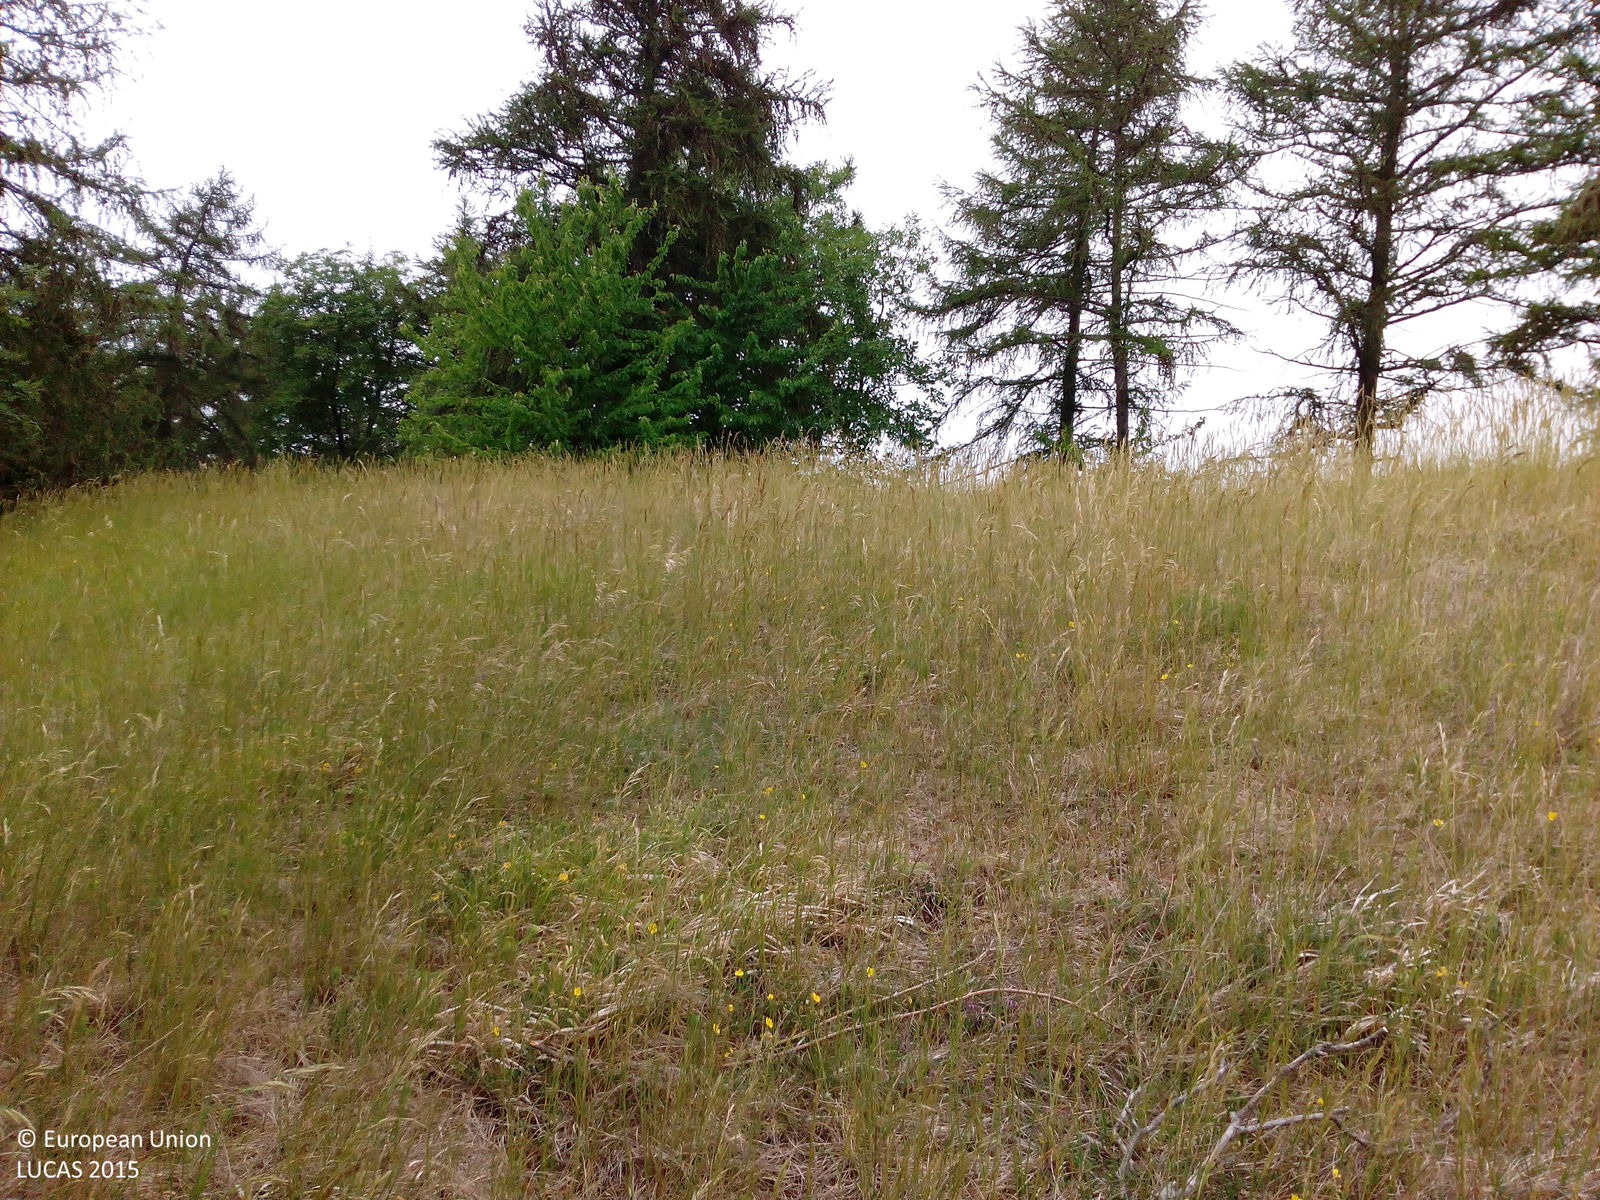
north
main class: Woodland
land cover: Spruce dominated coniferous woodland
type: hemiboreal forest and nemoral coniferous forest and mixed broadleaved-coniferous forest
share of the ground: 10 - 25 %
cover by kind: herbaceous plants 80 %, coniferous forest trees 15 %, shrubs 5 %
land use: Agriculture (excluding fallow land and kitchen gardens)
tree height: > 5 m
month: June
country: DE
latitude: 50.9915
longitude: 10.6409
